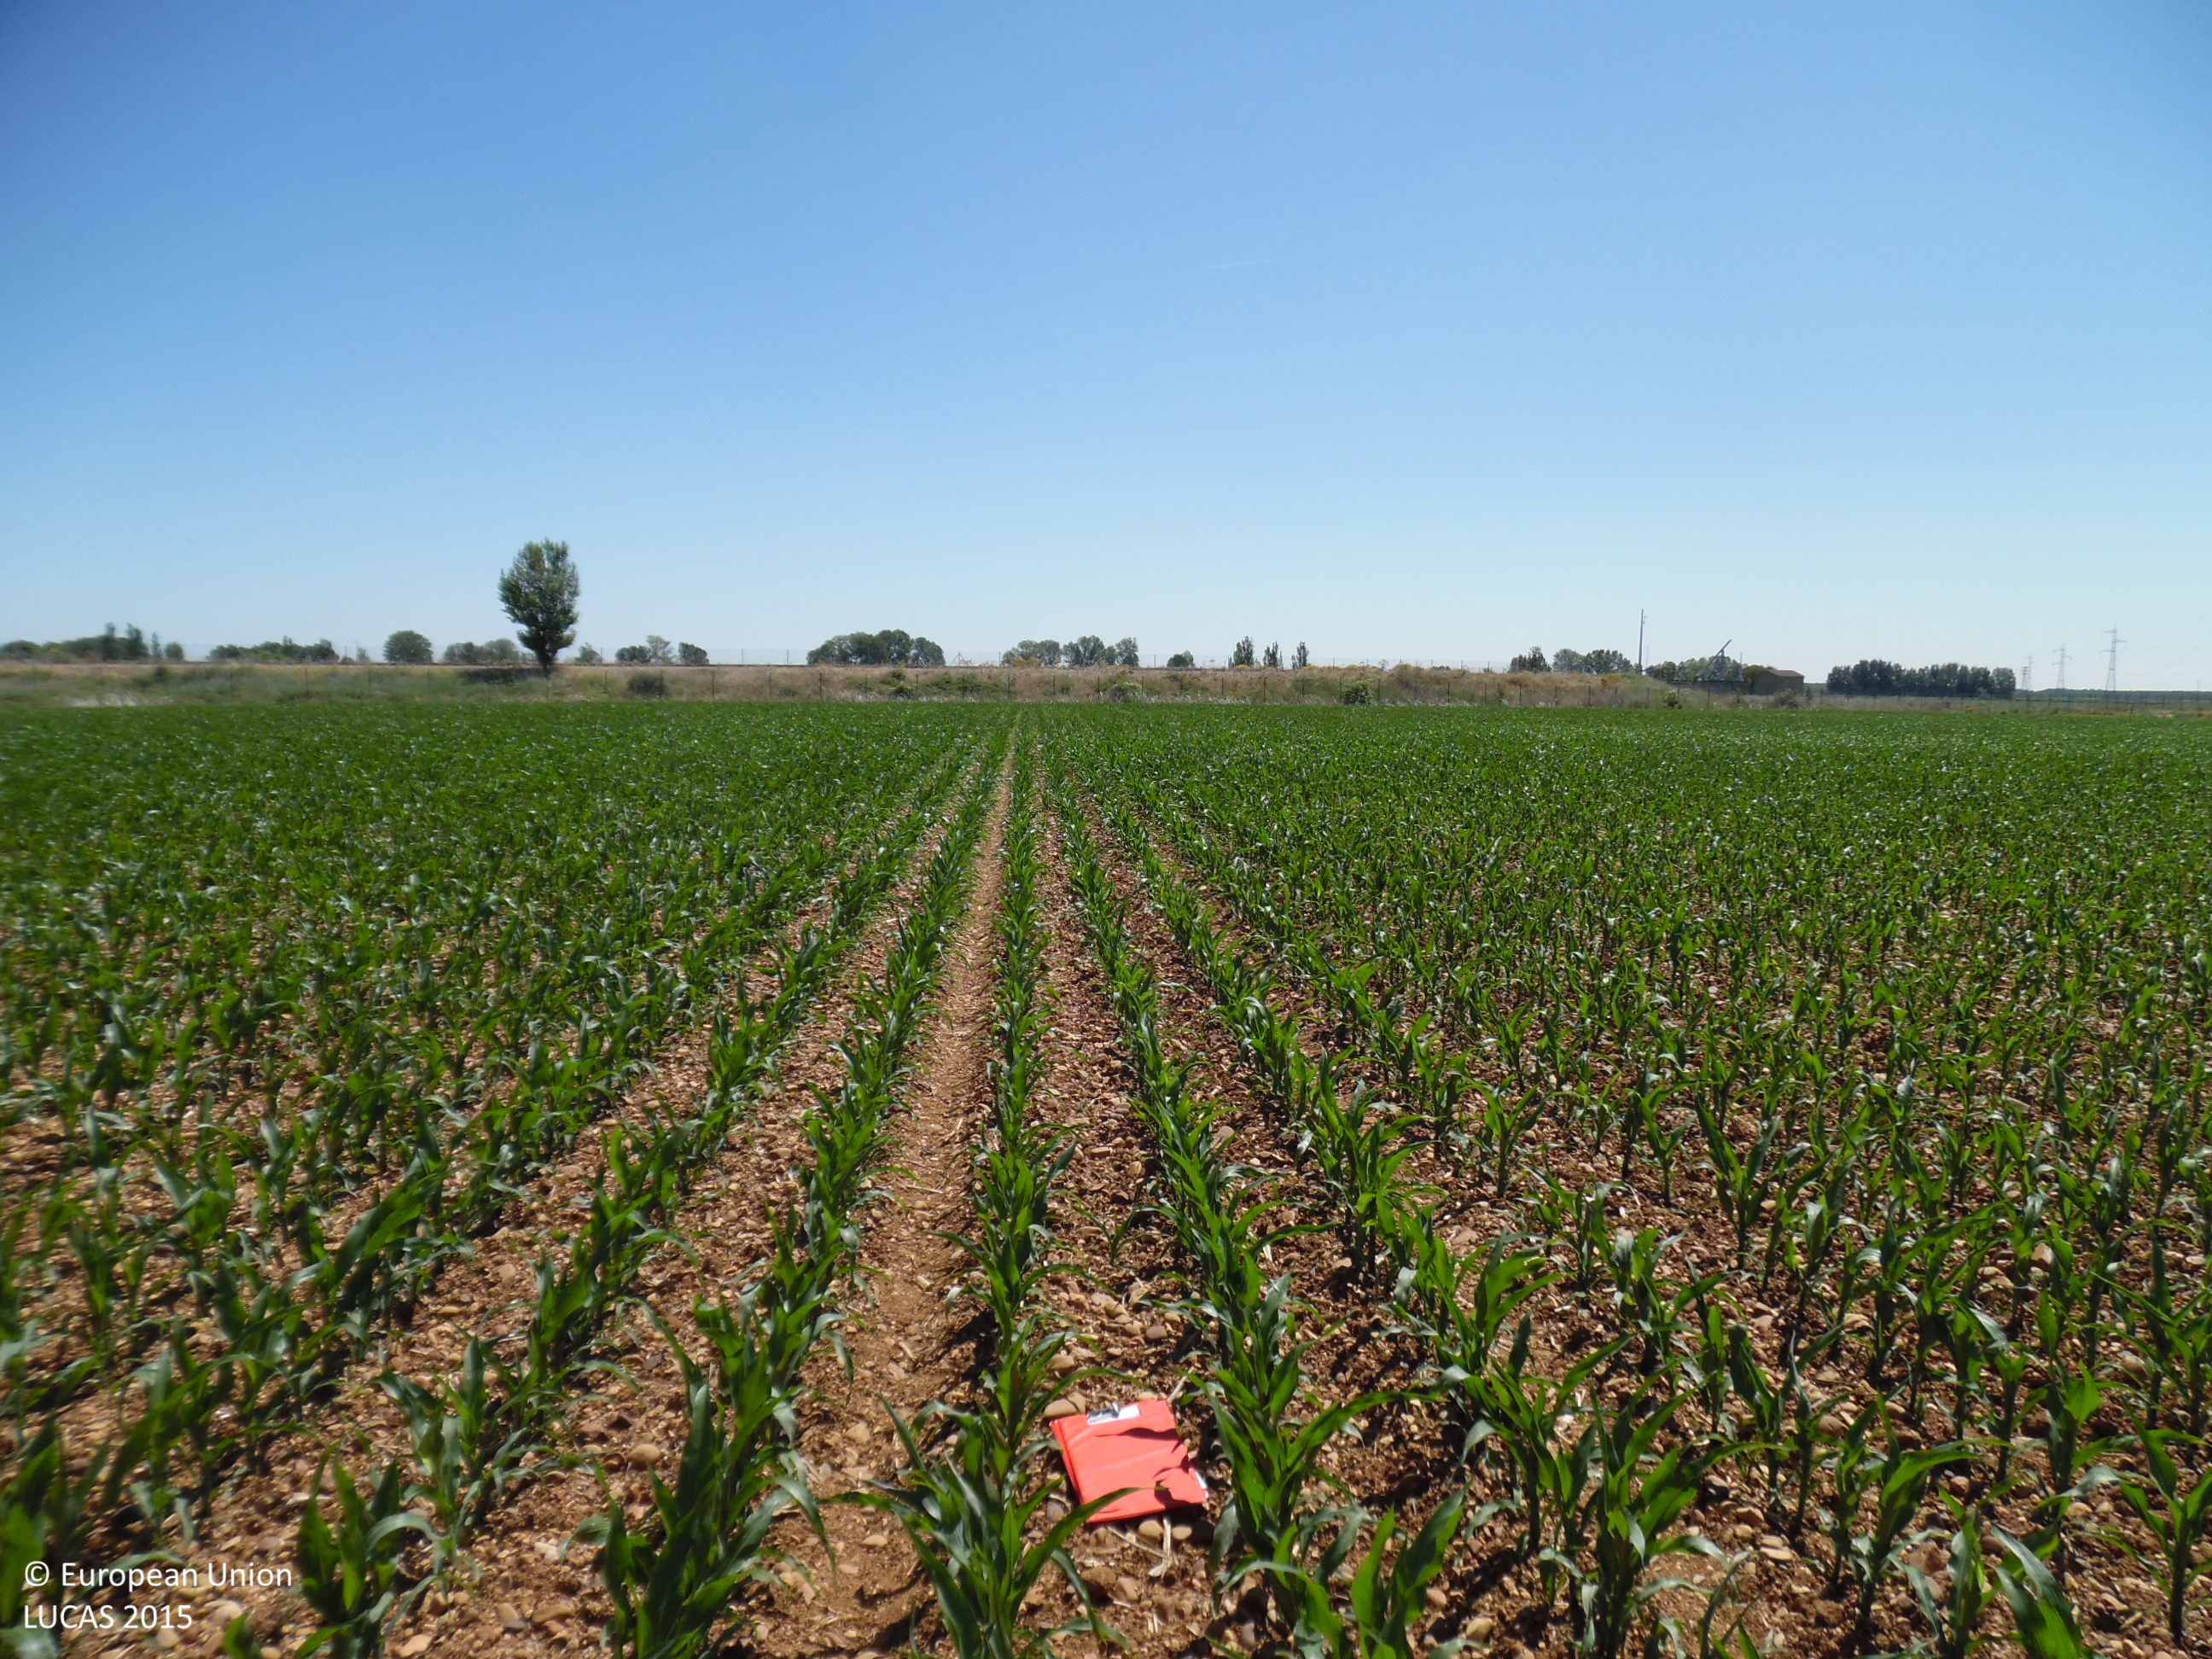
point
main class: Cropland
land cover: Maize
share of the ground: 25 - 50 %
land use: Agriculture (excluding fallow land and kitchen gardens)
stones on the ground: < 10 %
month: June
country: ES
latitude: 42.3223
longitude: -5.6886
